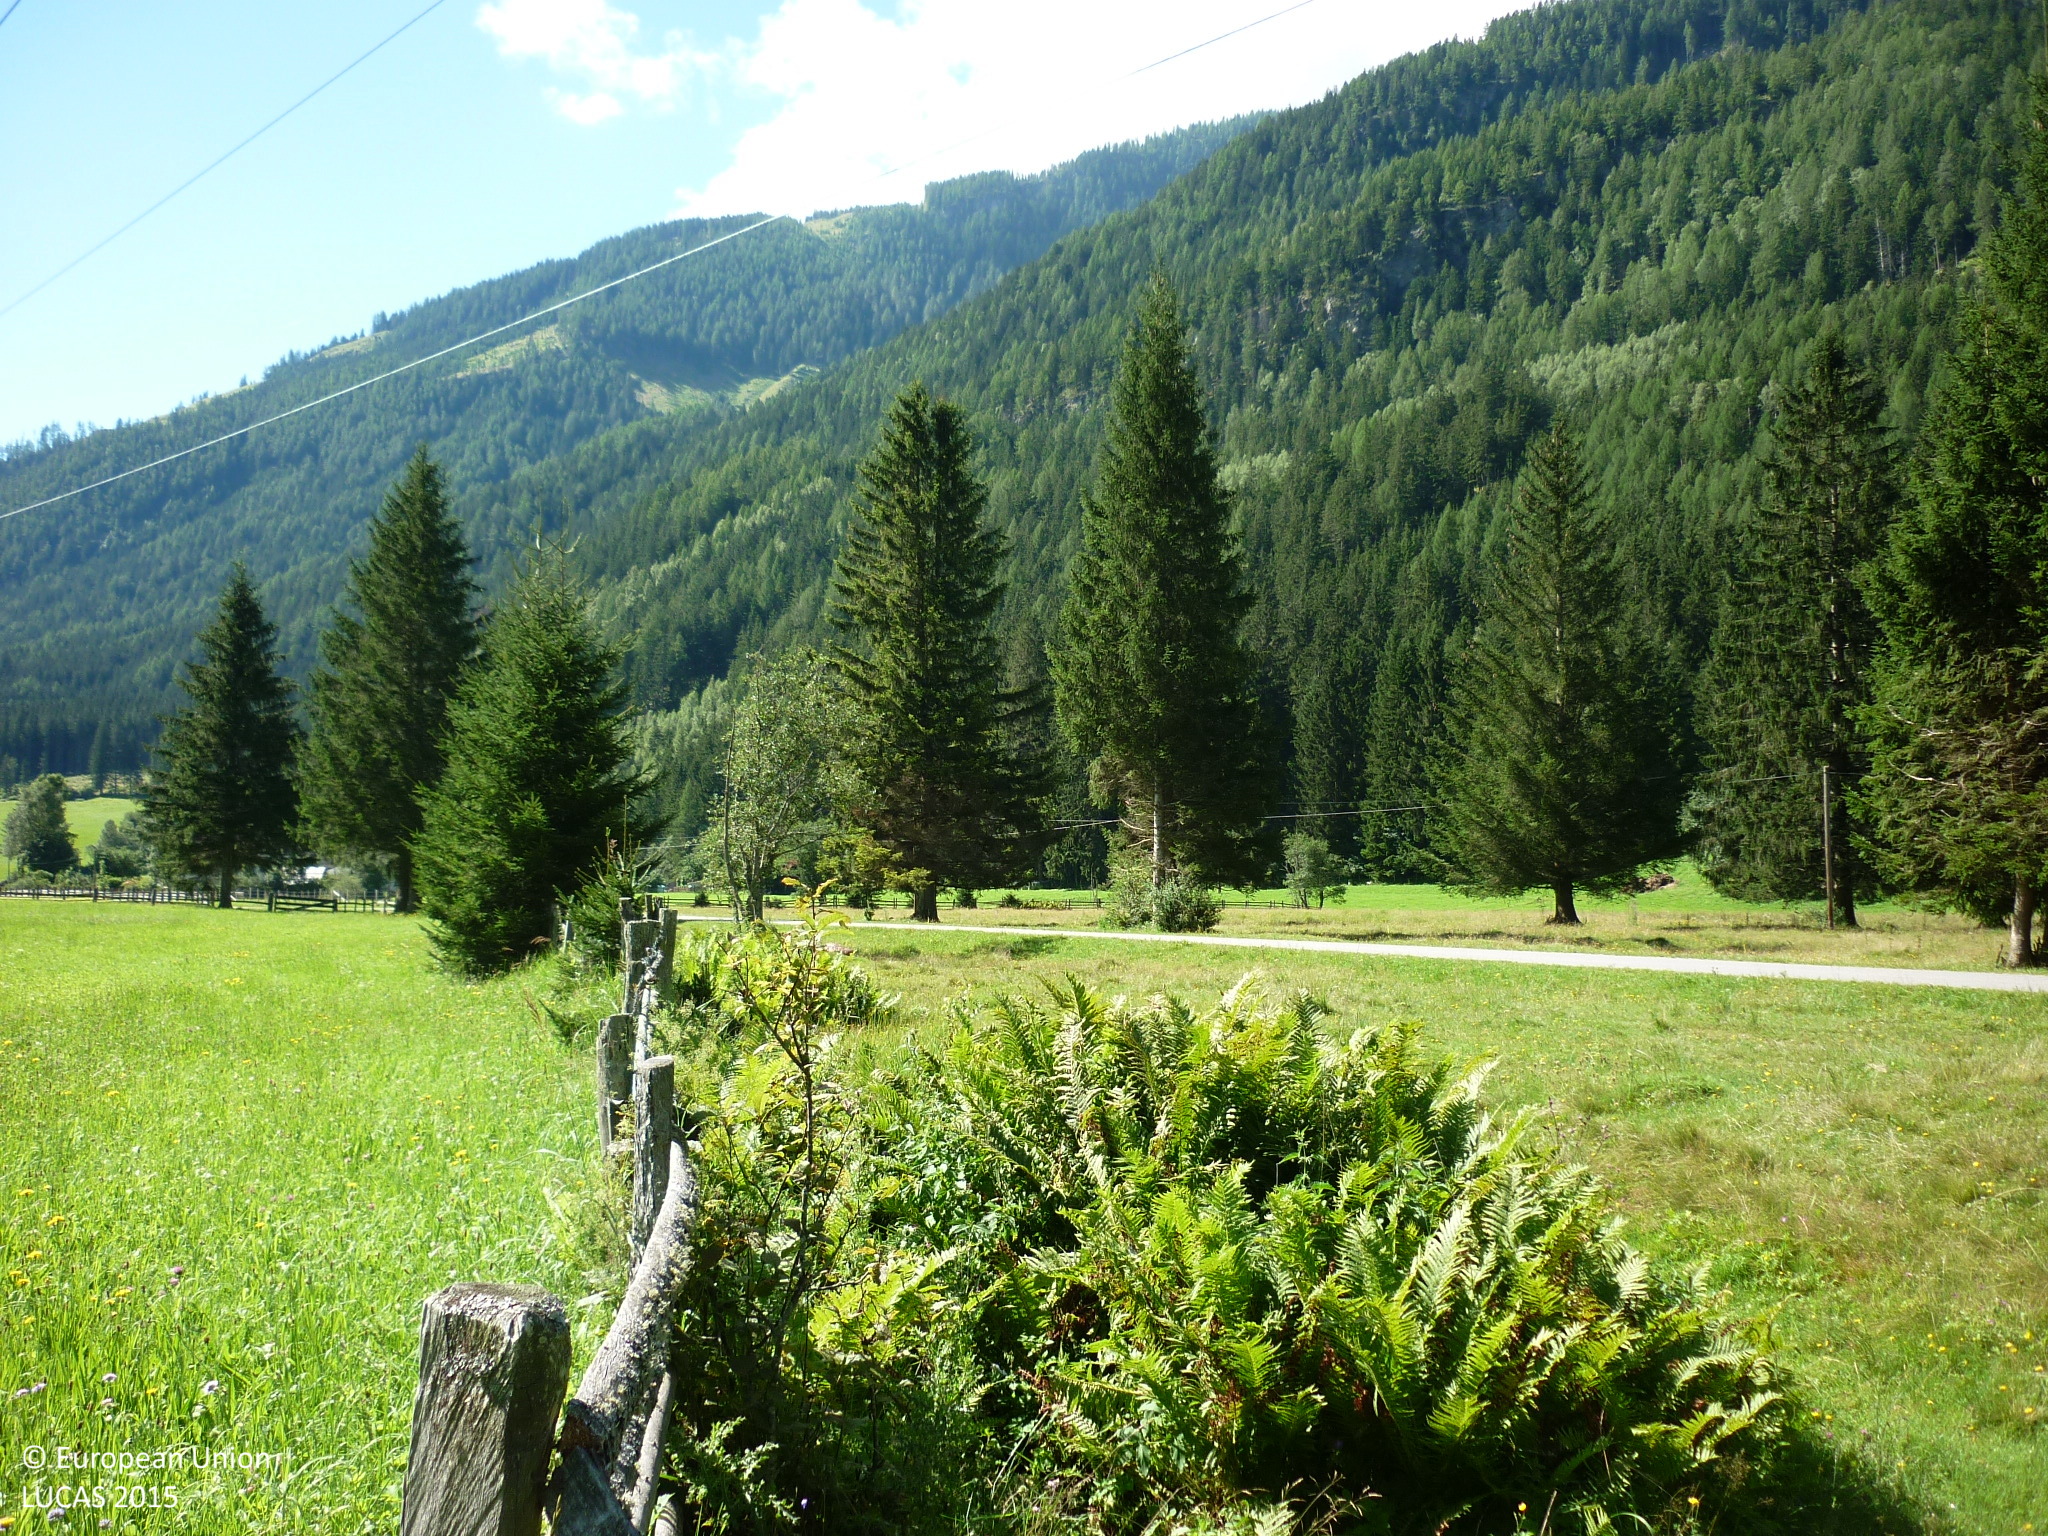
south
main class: Grassland
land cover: Grassland without tree/shrub cover
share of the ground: > 75 %
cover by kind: herbaceous plants 100 %
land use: Agriculture (excluding fallow land and kitchen gardens)
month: August
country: AT
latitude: 46.9615
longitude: 13.4802
